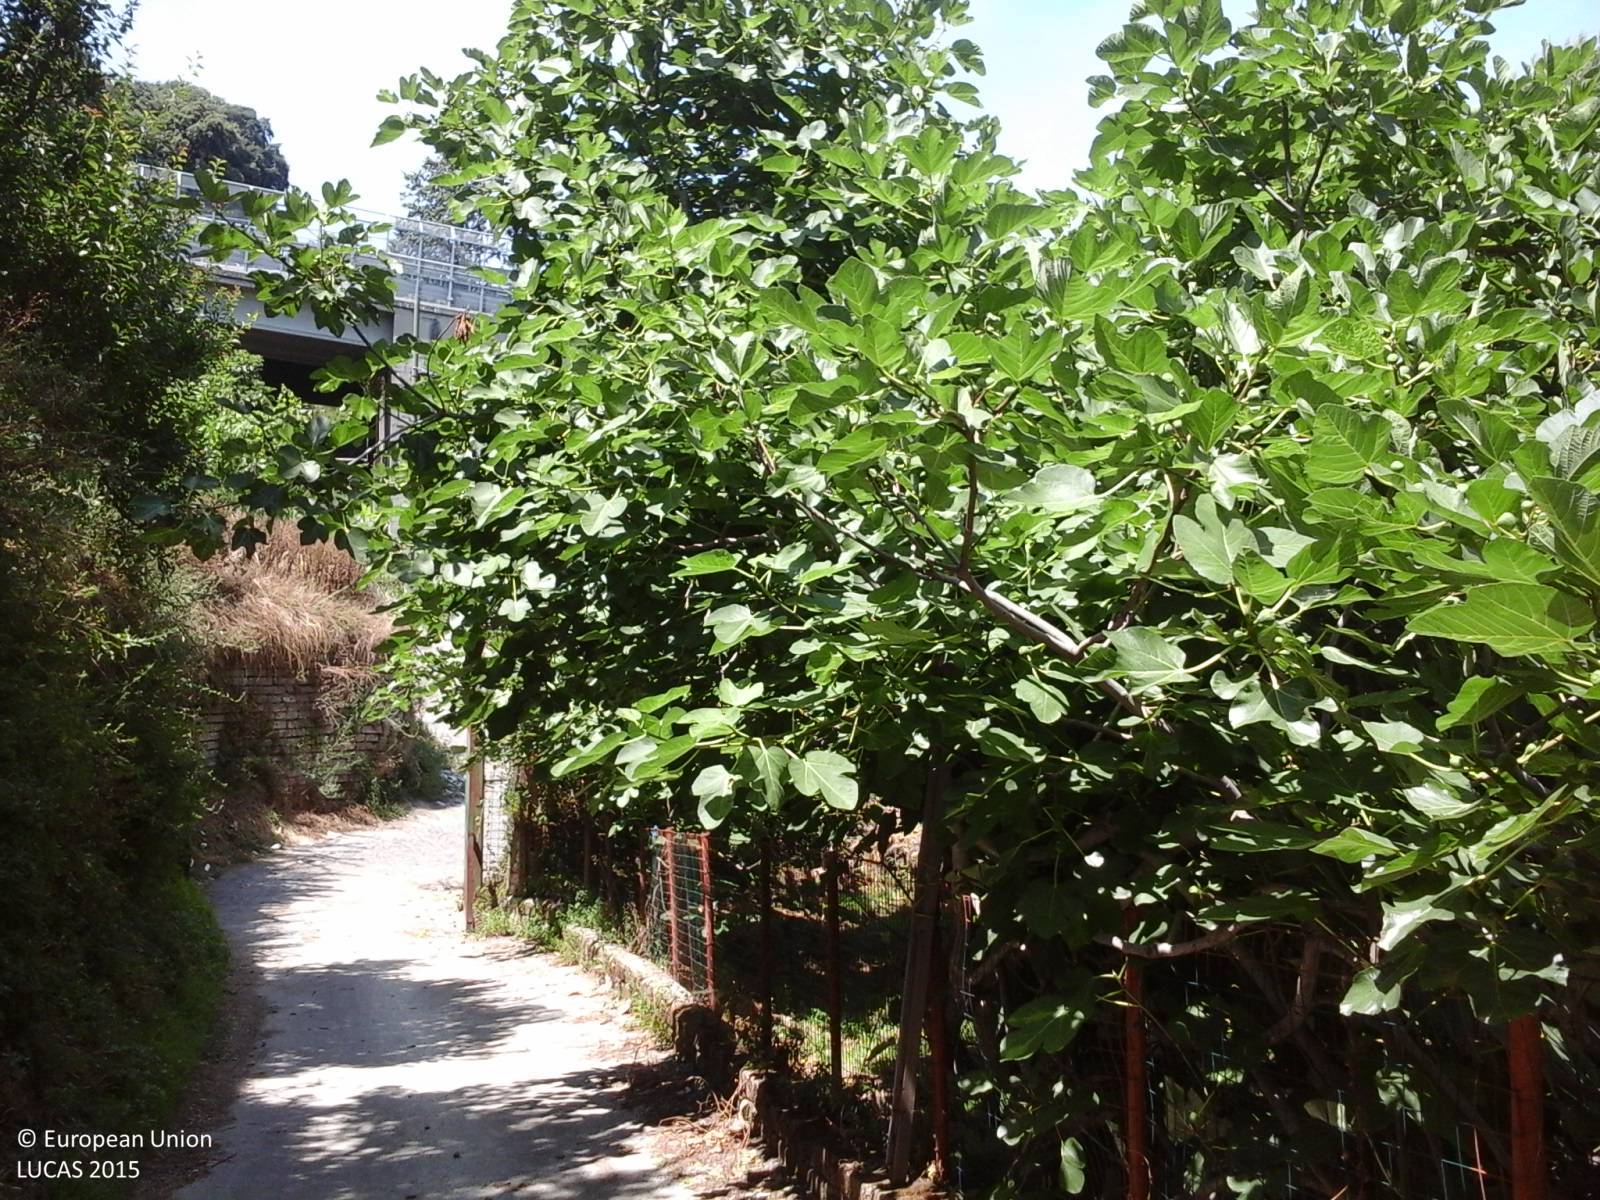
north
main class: Cropland
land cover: Other fruit trees and berries
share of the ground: > 75 %
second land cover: Spontaneously vegetated surfaces
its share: > 75 %
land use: Agriculture (excluding fallow land and kitchen gardens)
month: June
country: IT
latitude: 40.8641
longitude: 14.2415
